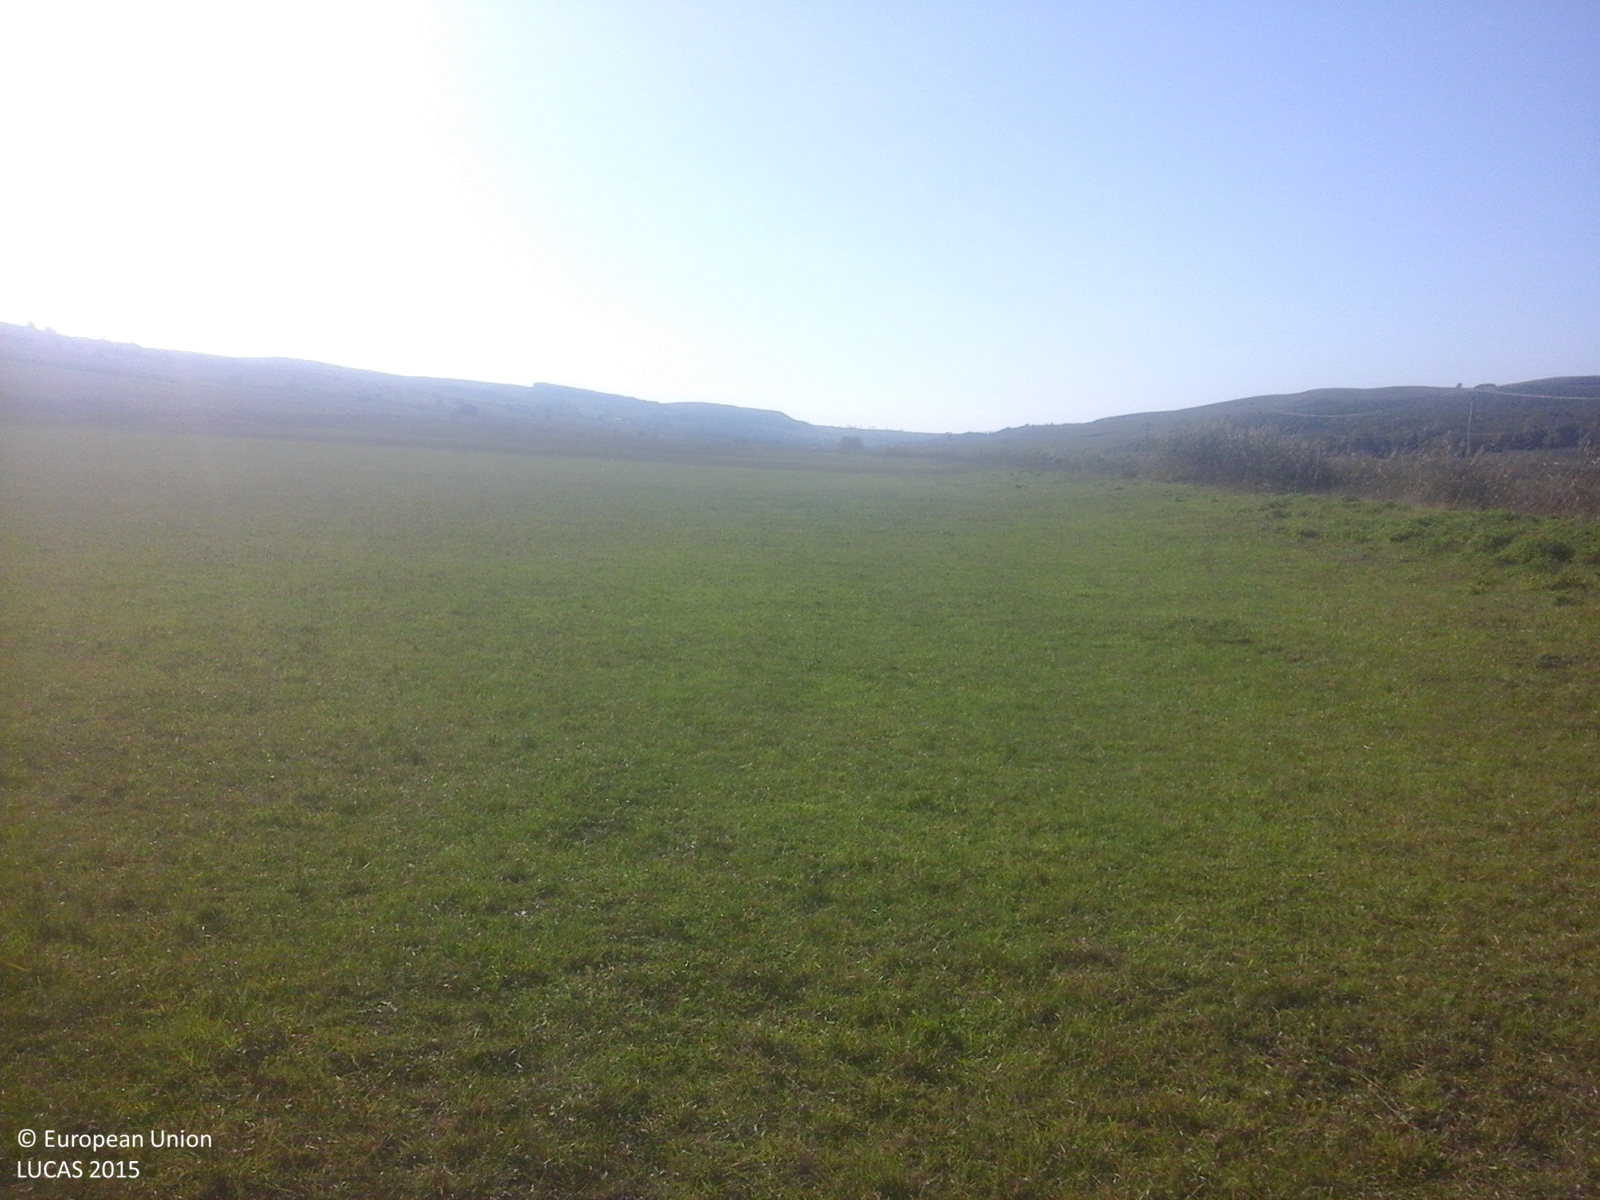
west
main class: Grassland
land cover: Grassland without tree/shrub cover
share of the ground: > 75 %
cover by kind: herbaceous plants 100 %
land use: Agriculture (excluding fallow land and kitchen gardens)
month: October
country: RO
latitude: 45.9311
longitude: 24.0406
